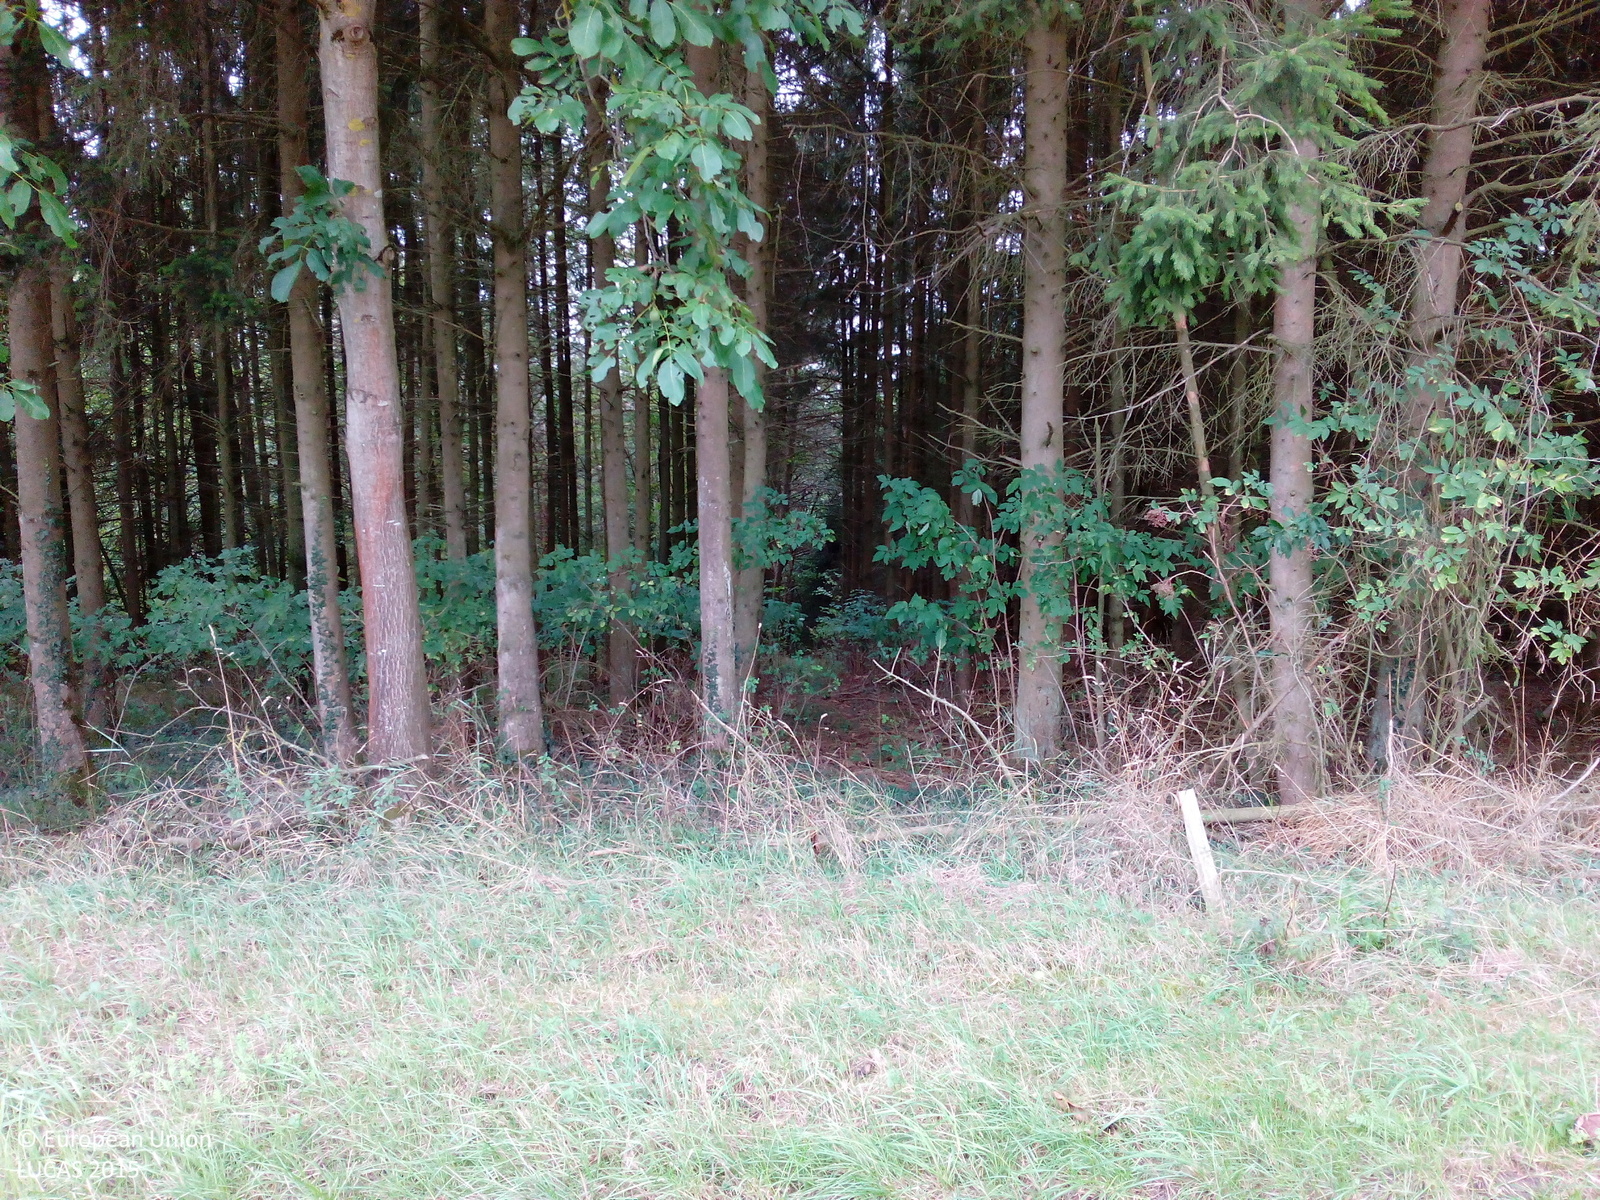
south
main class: Cropland
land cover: Common wheat
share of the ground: < 10 %
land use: Agriculture (excluding fallow land and kitchen gardens)
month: September
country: DE
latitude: 49.8237
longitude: 9.5692
